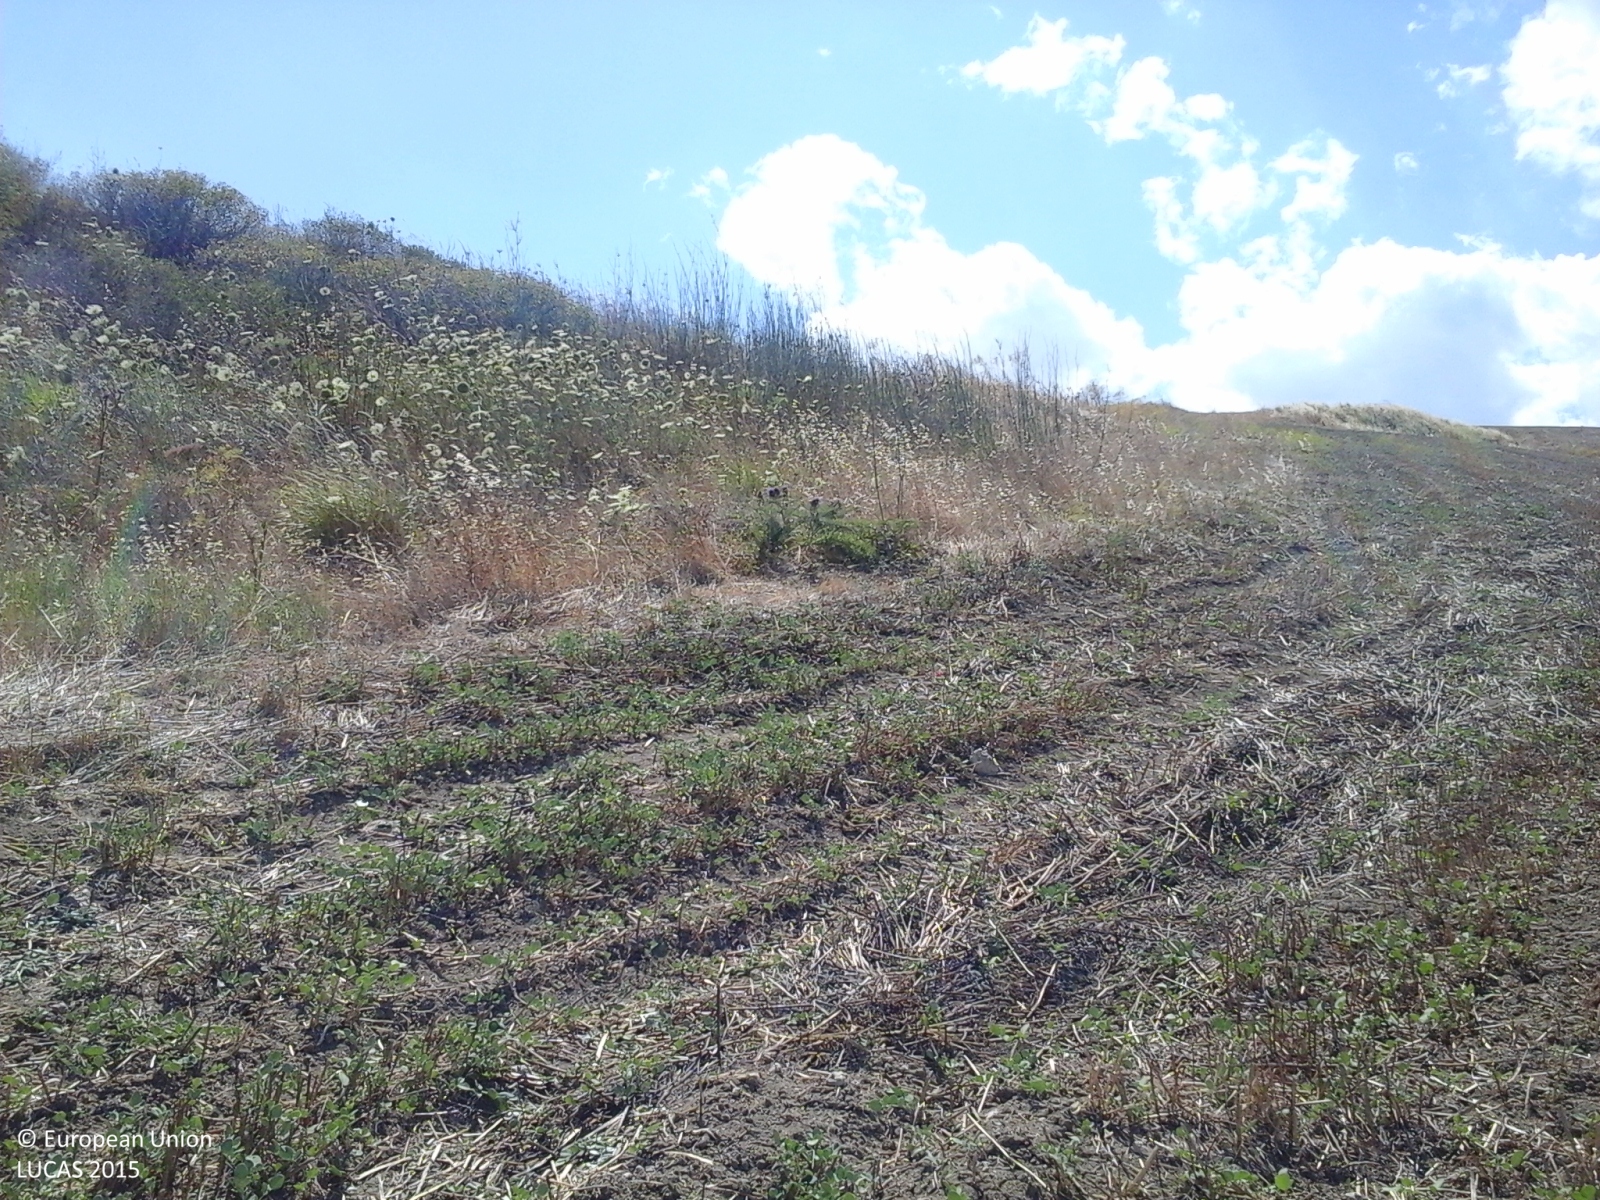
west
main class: Grassland
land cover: Grassland with sparse tree/shrub cover
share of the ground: > 75 %
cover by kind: herbaceous plants 85 %, shrubs 10 %, broadleaved forest trees 5 %
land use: Agriculture (excluding fallow land and kitchen gardens)
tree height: < 5 m
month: June
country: IT
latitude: 37.7911
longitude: 13.5286
